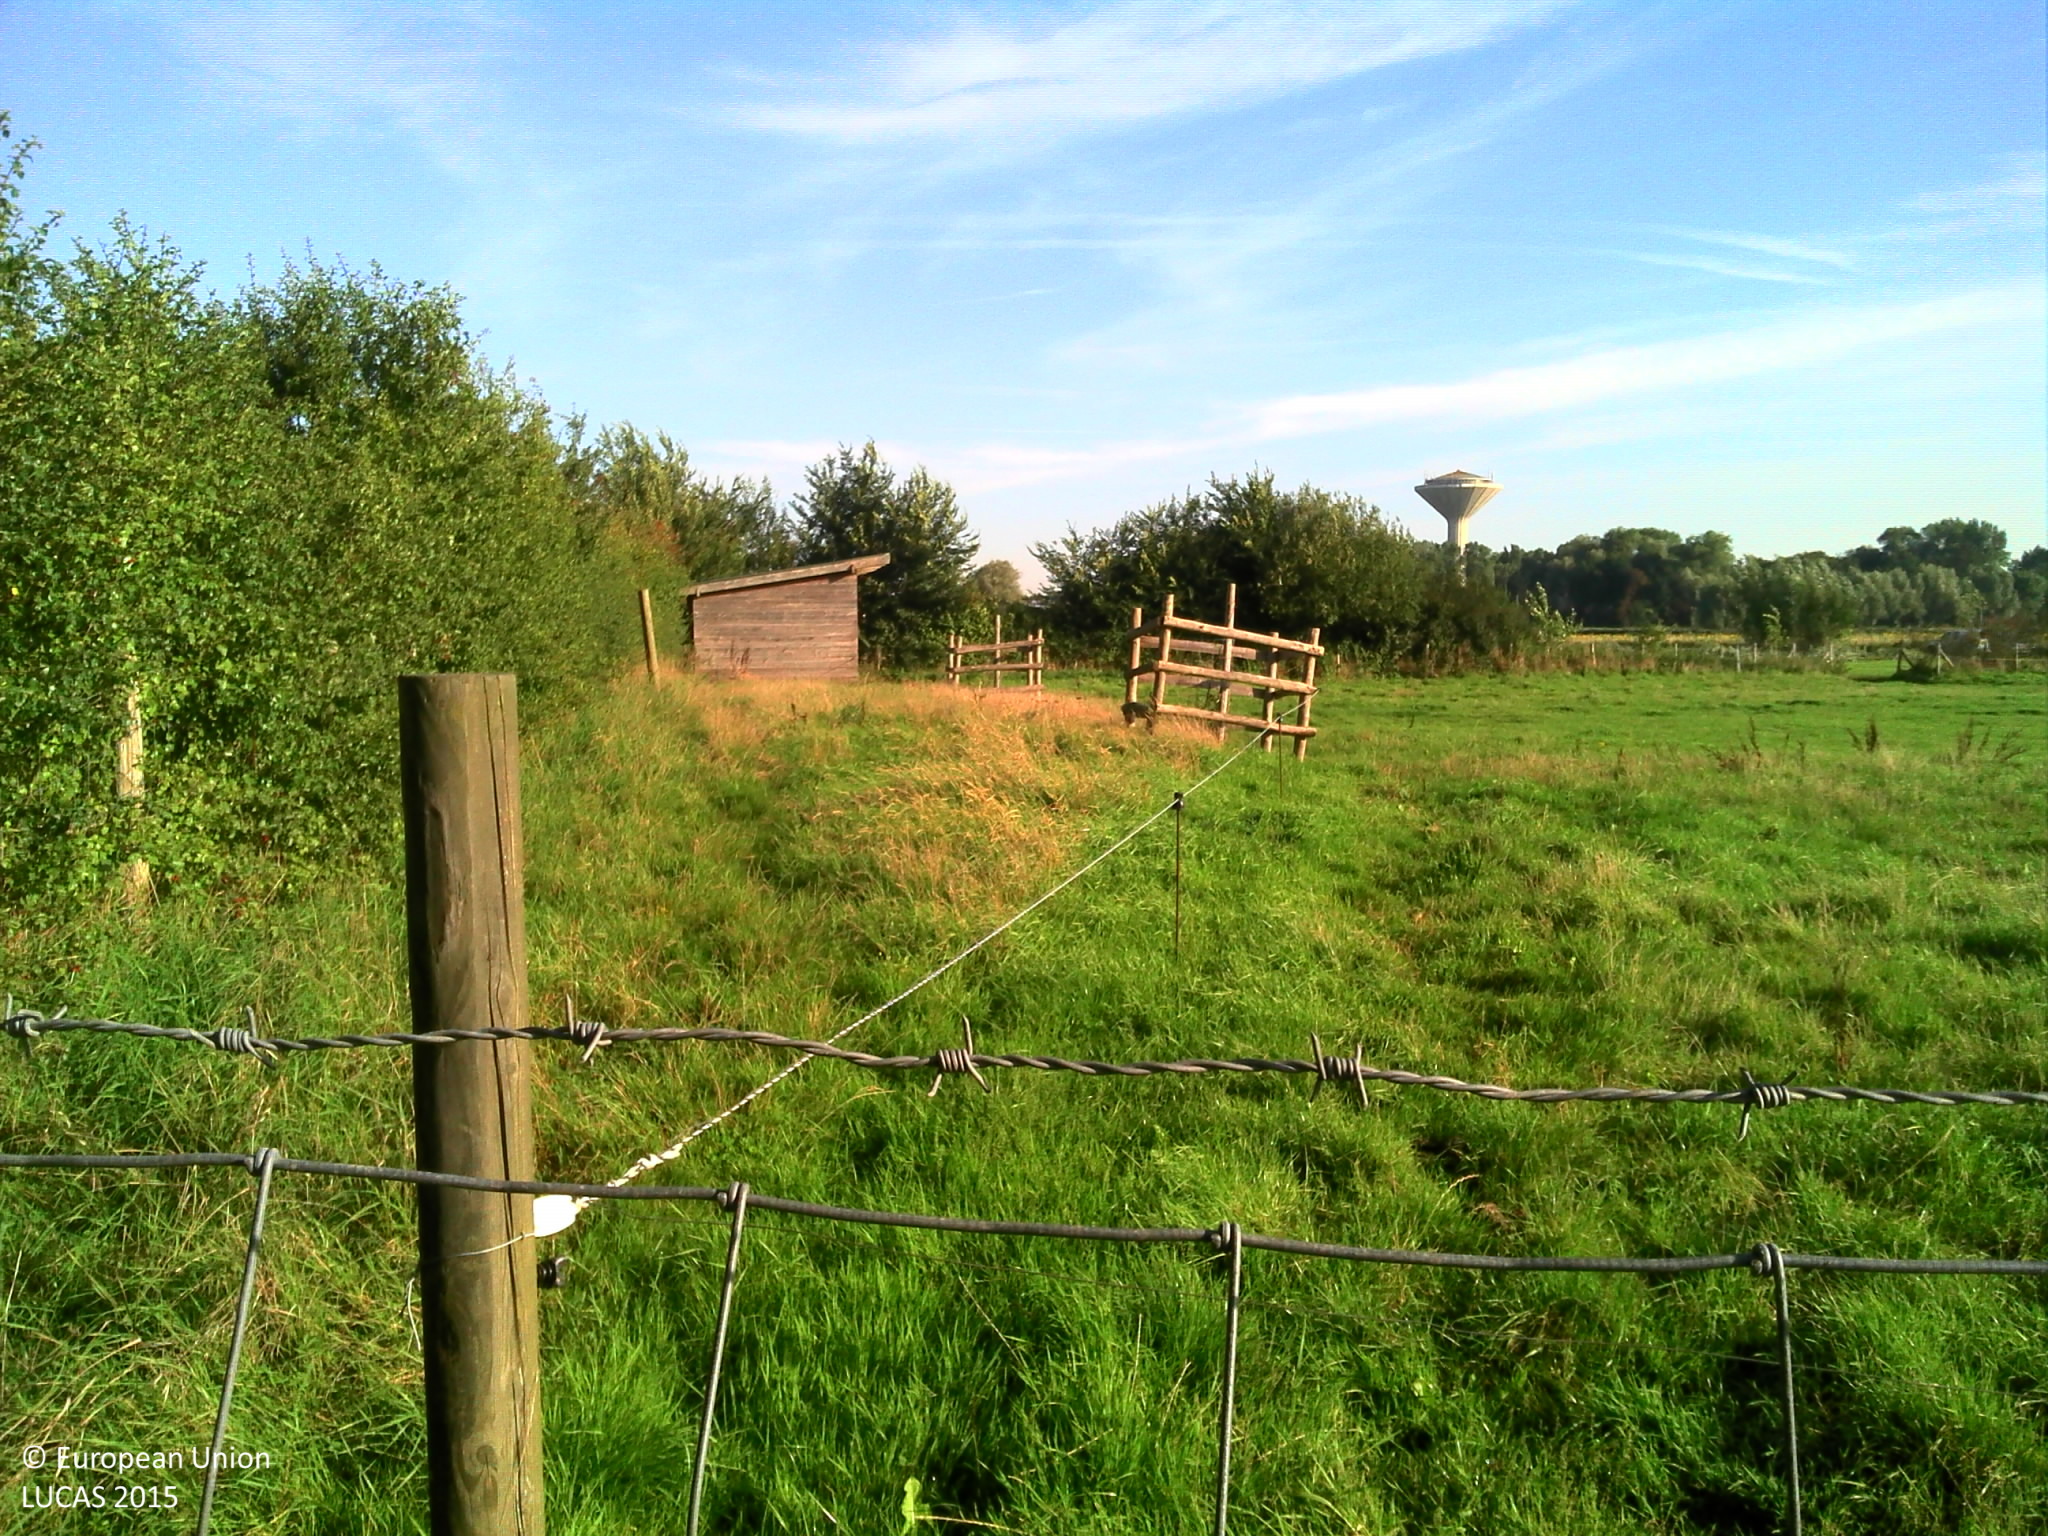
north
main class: Grassland
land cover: Grassland without tree/shrub cover
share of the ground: > 75 %
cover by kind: herbaceous plants 100 %
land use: Agriculture (excluding fallow land and kitchen gardens)
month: September
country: BE
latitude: 51.1247
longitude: 2.7157
